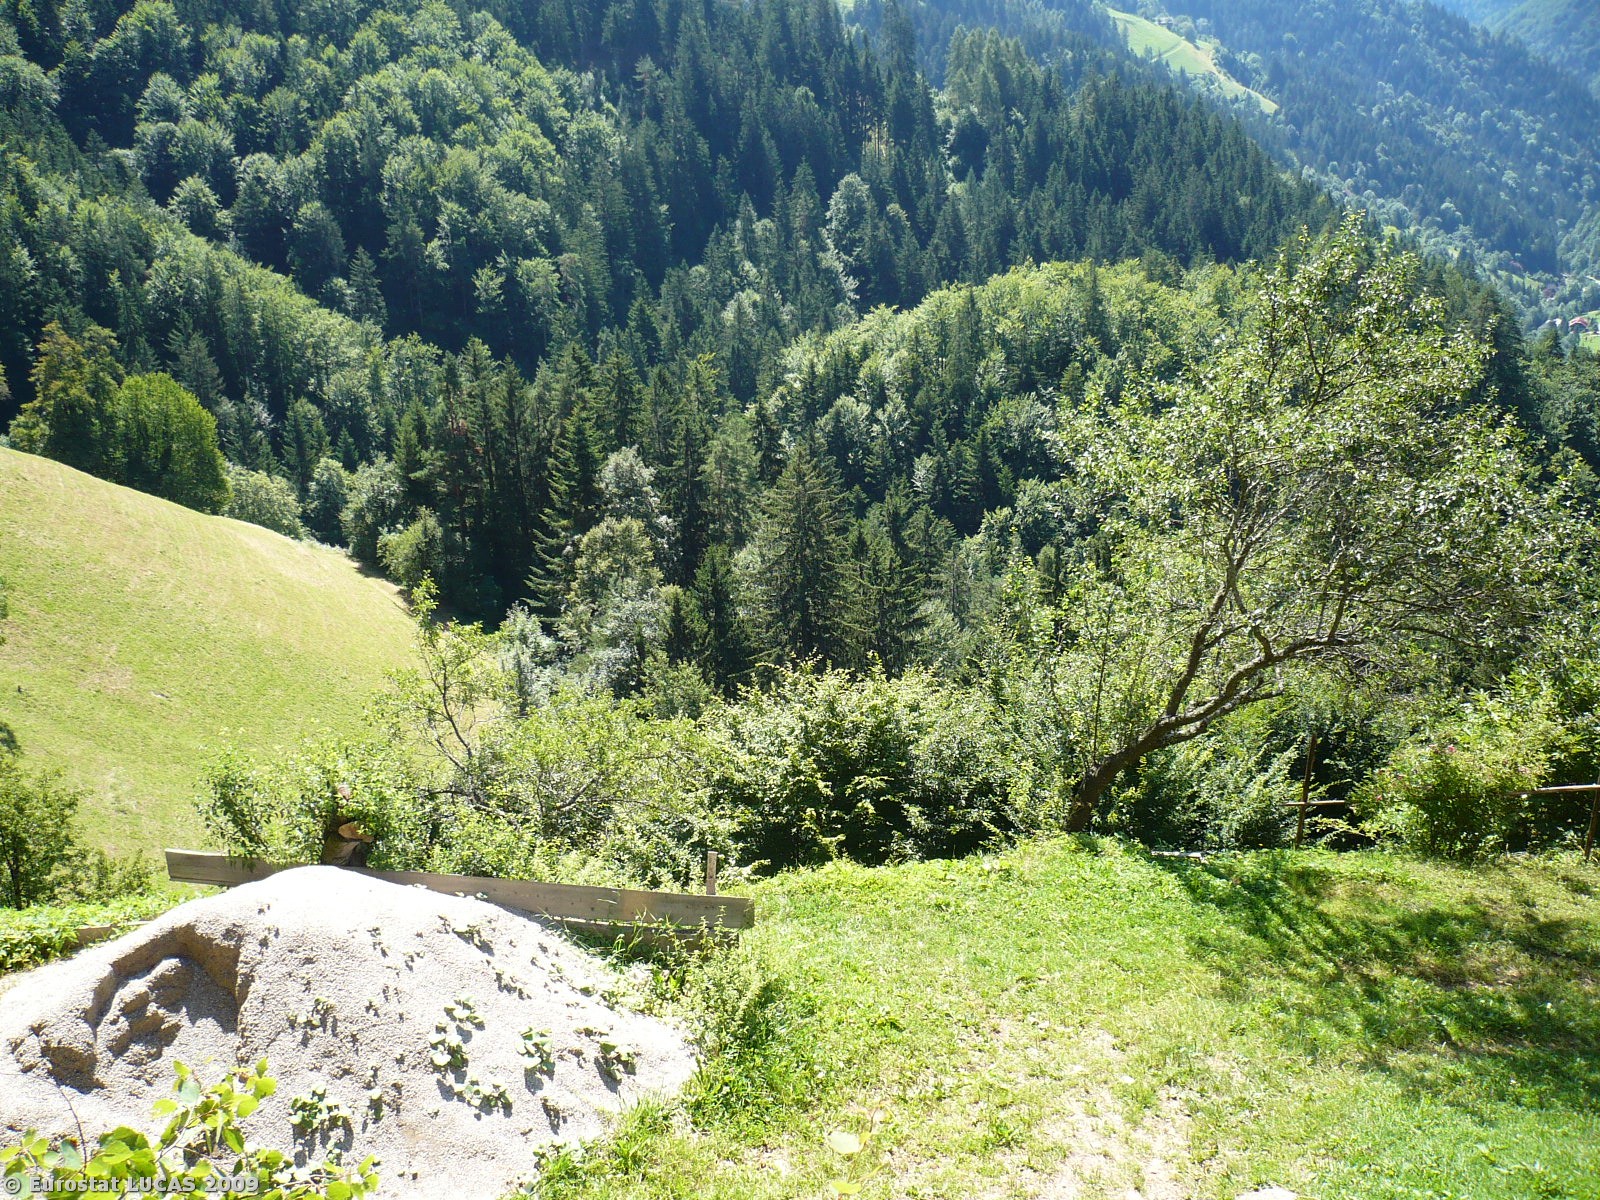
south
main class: Shrubland
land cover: Shrubland with sparse tree cover
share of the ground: > 75 %
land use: Unused
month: July
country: SI
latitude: 46.6149
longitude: 15.3393
